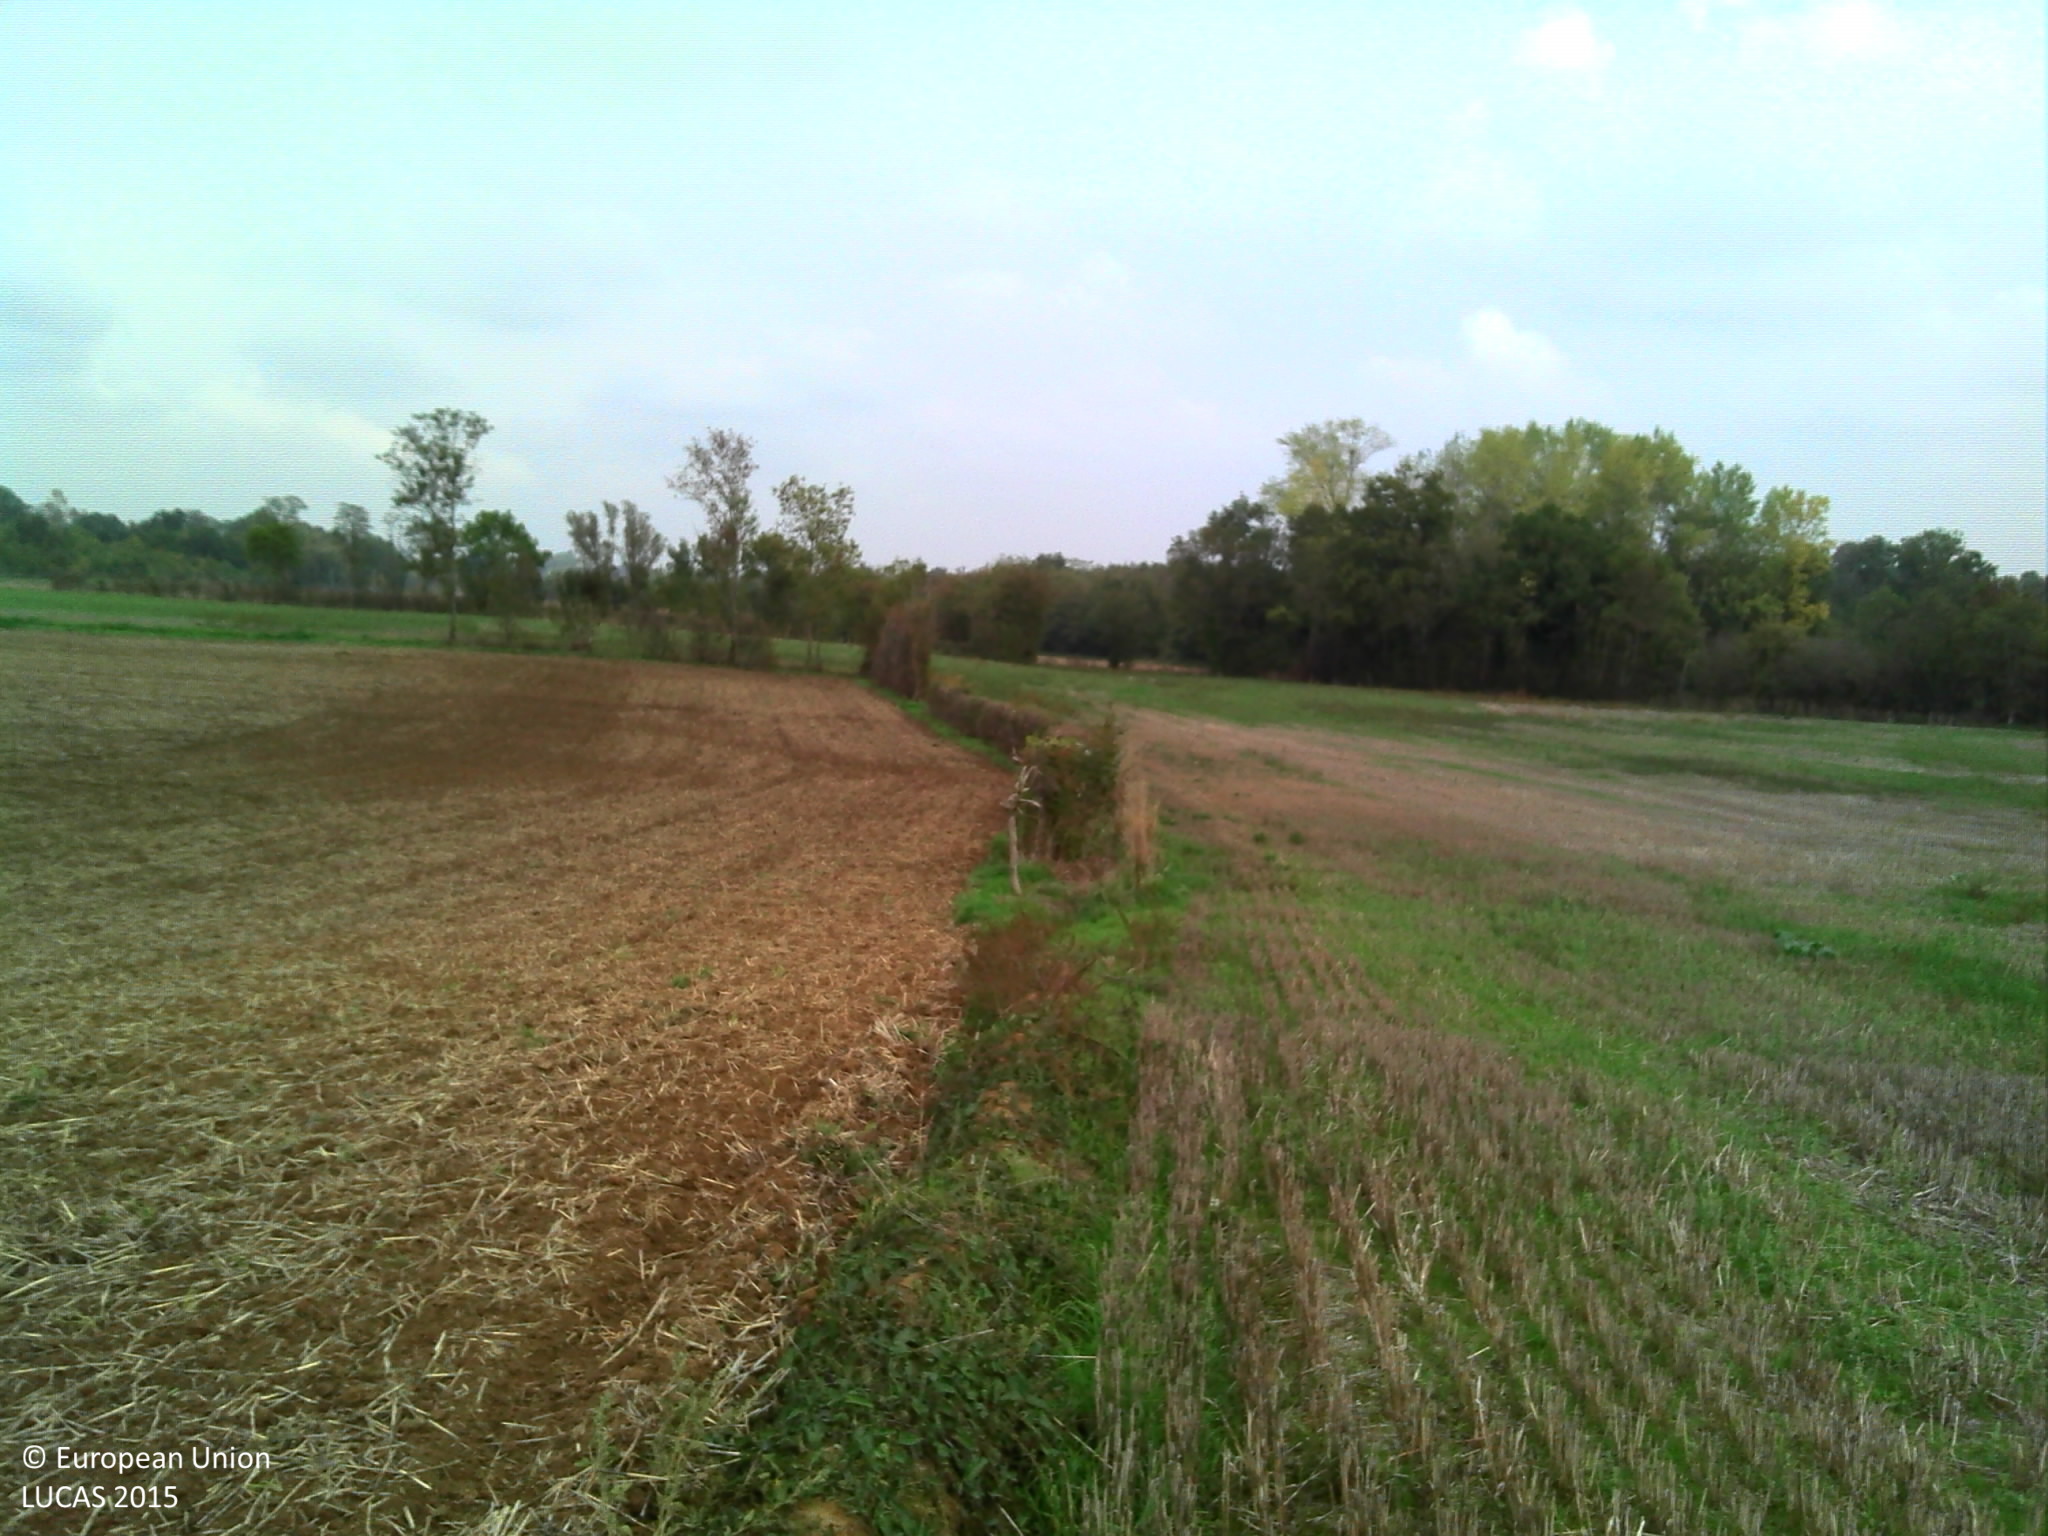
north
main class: Cropland
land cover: Common wheat
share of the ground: < 10 %
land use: Agriculture (excluding fallow land and kitchen gardens)
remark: Harvested field
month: October
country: FR
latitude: 46.1915
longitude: 4.8586
